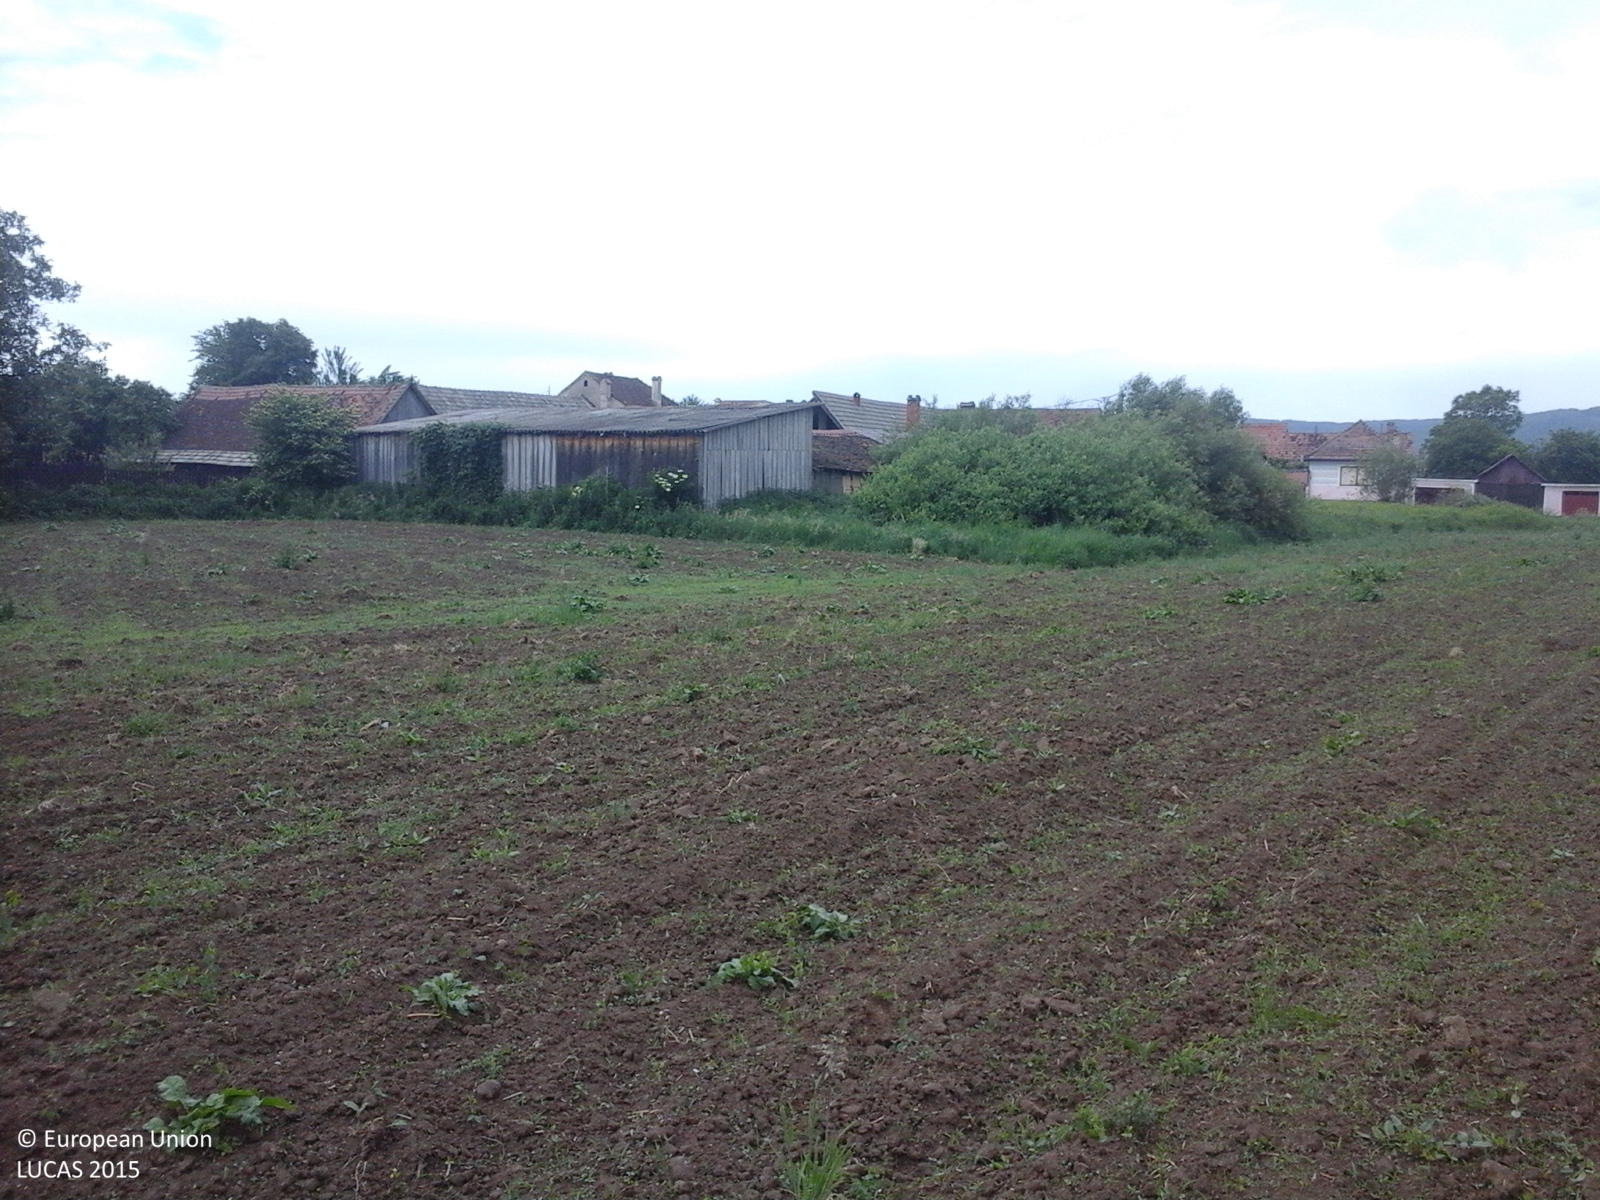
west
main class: Cropland
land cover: Lucerne
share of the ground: 10 - 25 %
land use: Agriculture (excluding fallow land and kitchen gardens)
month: May
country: RO
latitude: 45.8782
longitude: 25.2106
